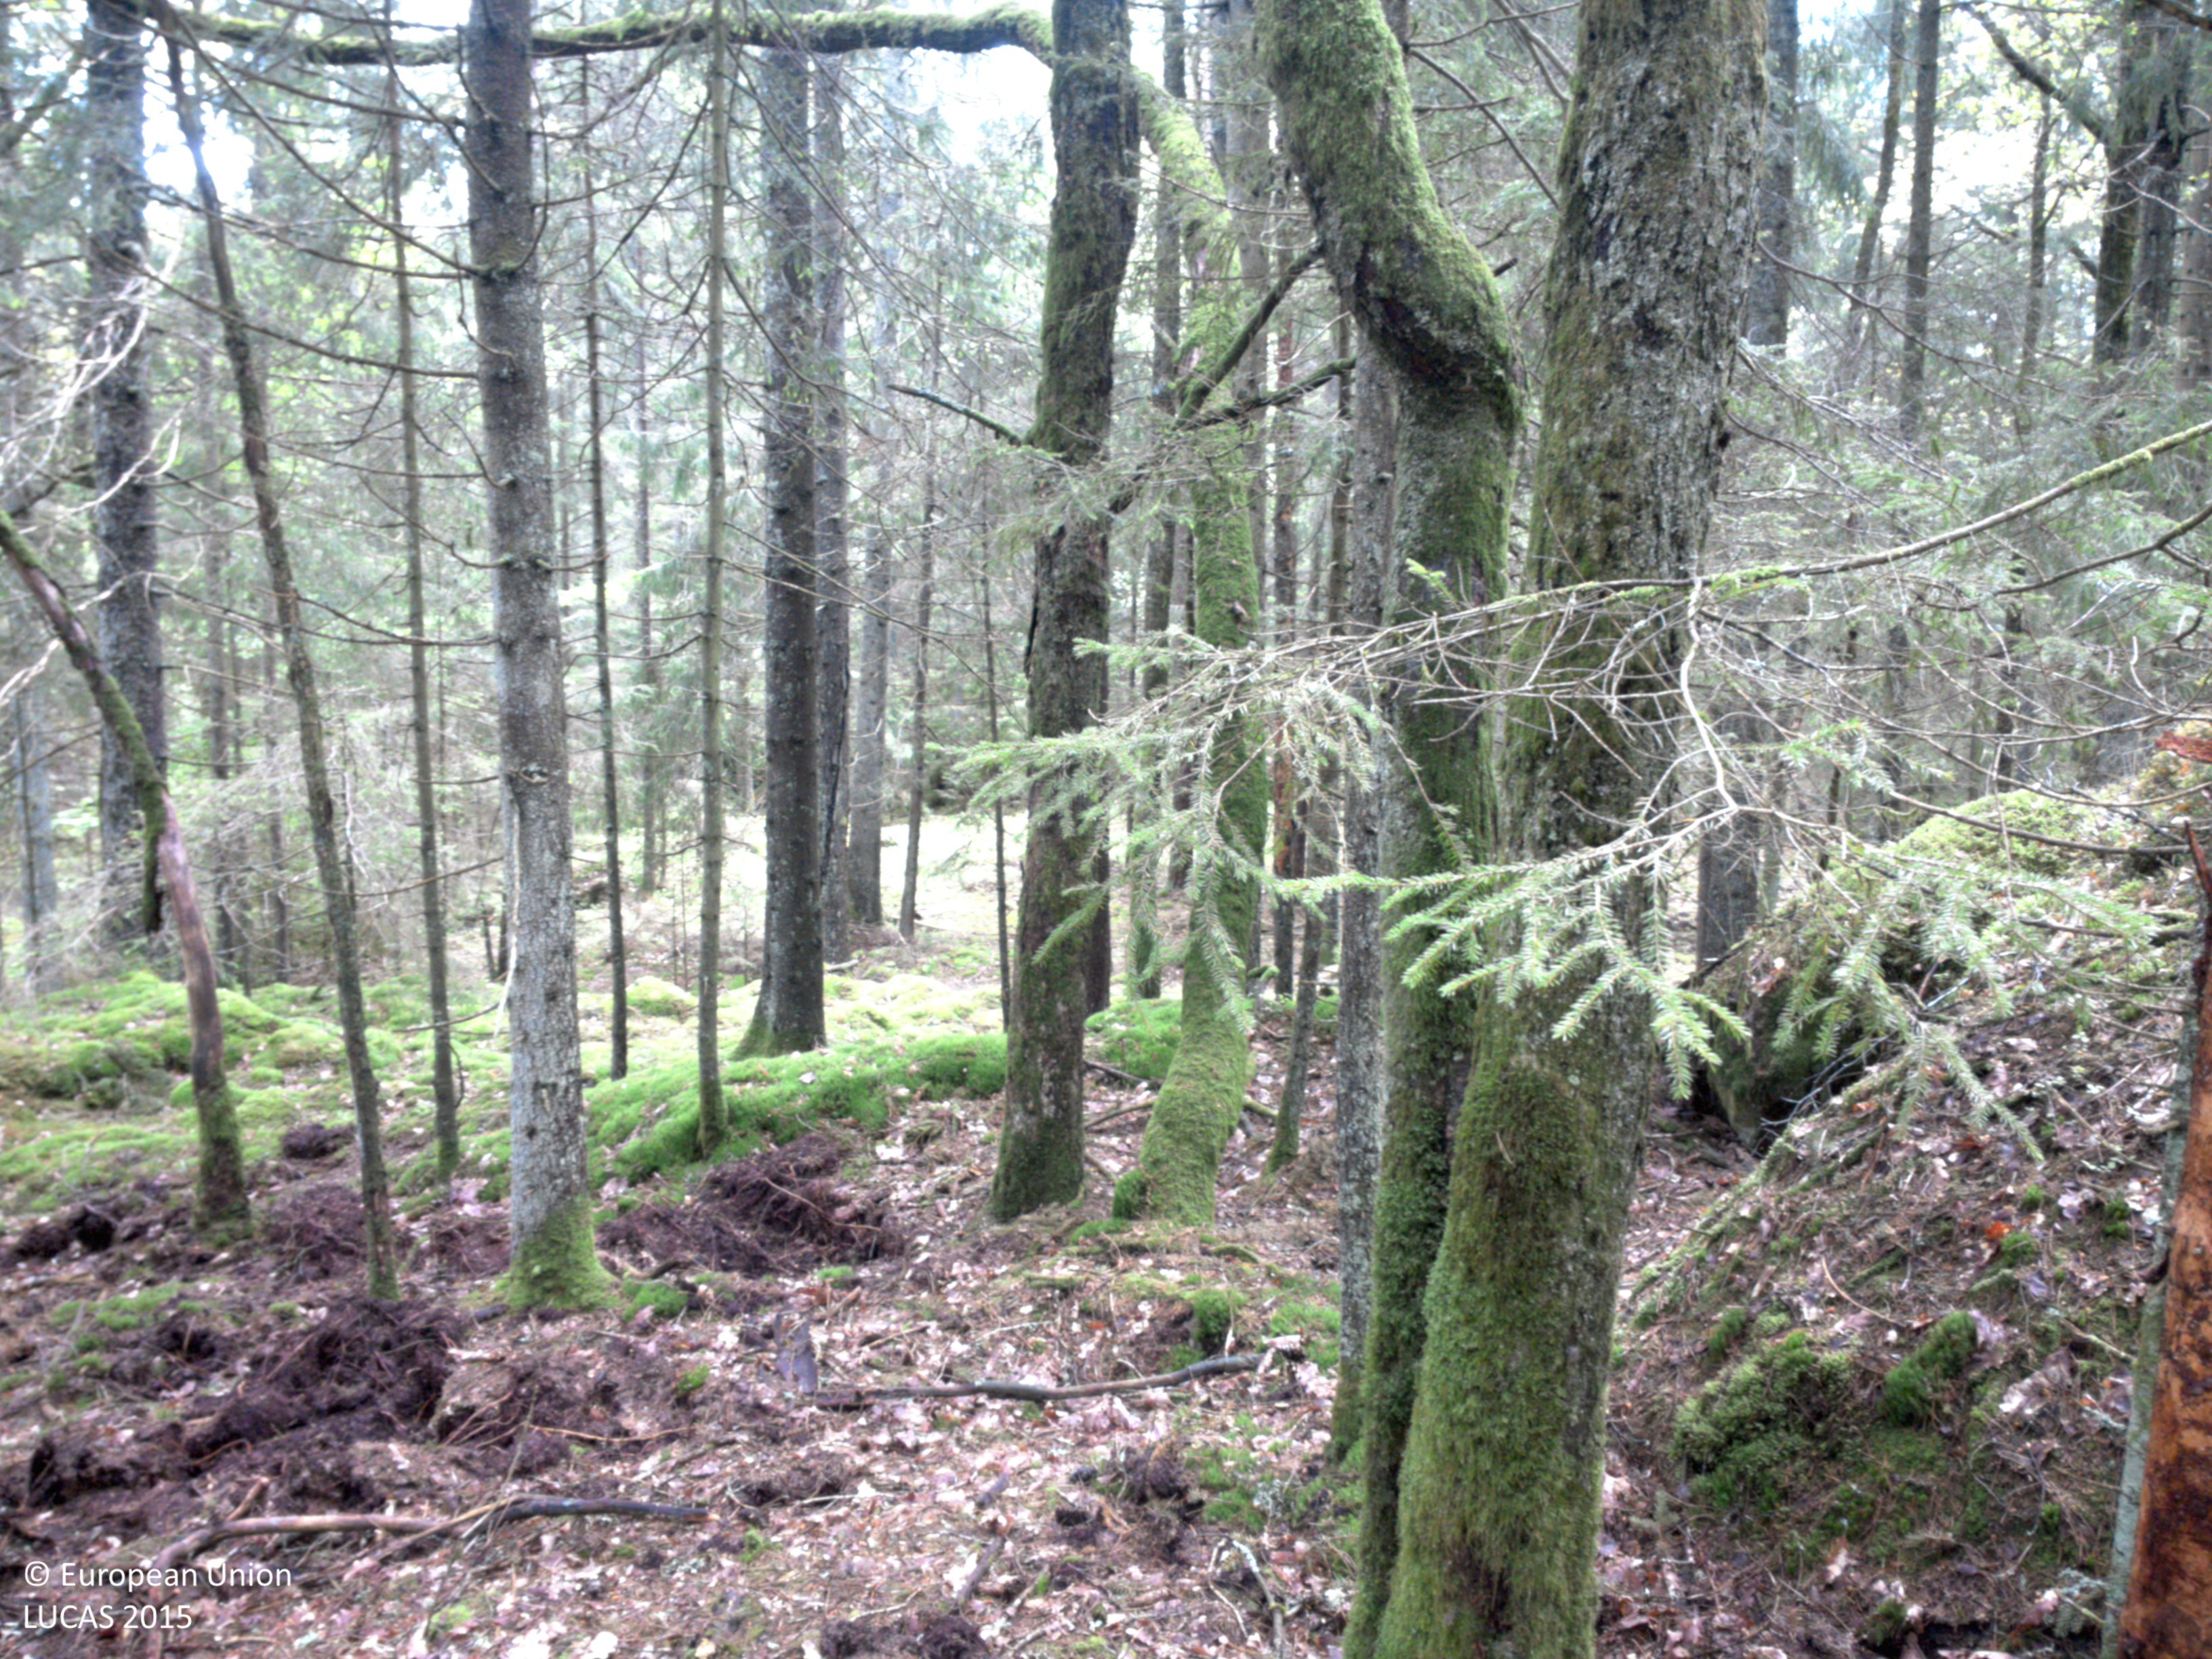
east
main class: Woodland
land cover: Spruce dominated coniferous woodland
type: boreal forest
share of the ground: 50 - 75 %
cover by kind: coniferous forest trees 65 %, herbaceous plants 35 %
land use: Forestry
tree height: > 5 m
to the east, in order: Spruce dominated coniferous woodland; Spruce dominated mixed woodland; Rivers and streams; Tracks; Spruce dominated mixed woodland
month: June
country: SE
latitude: 57.9711
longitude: 11.9744
